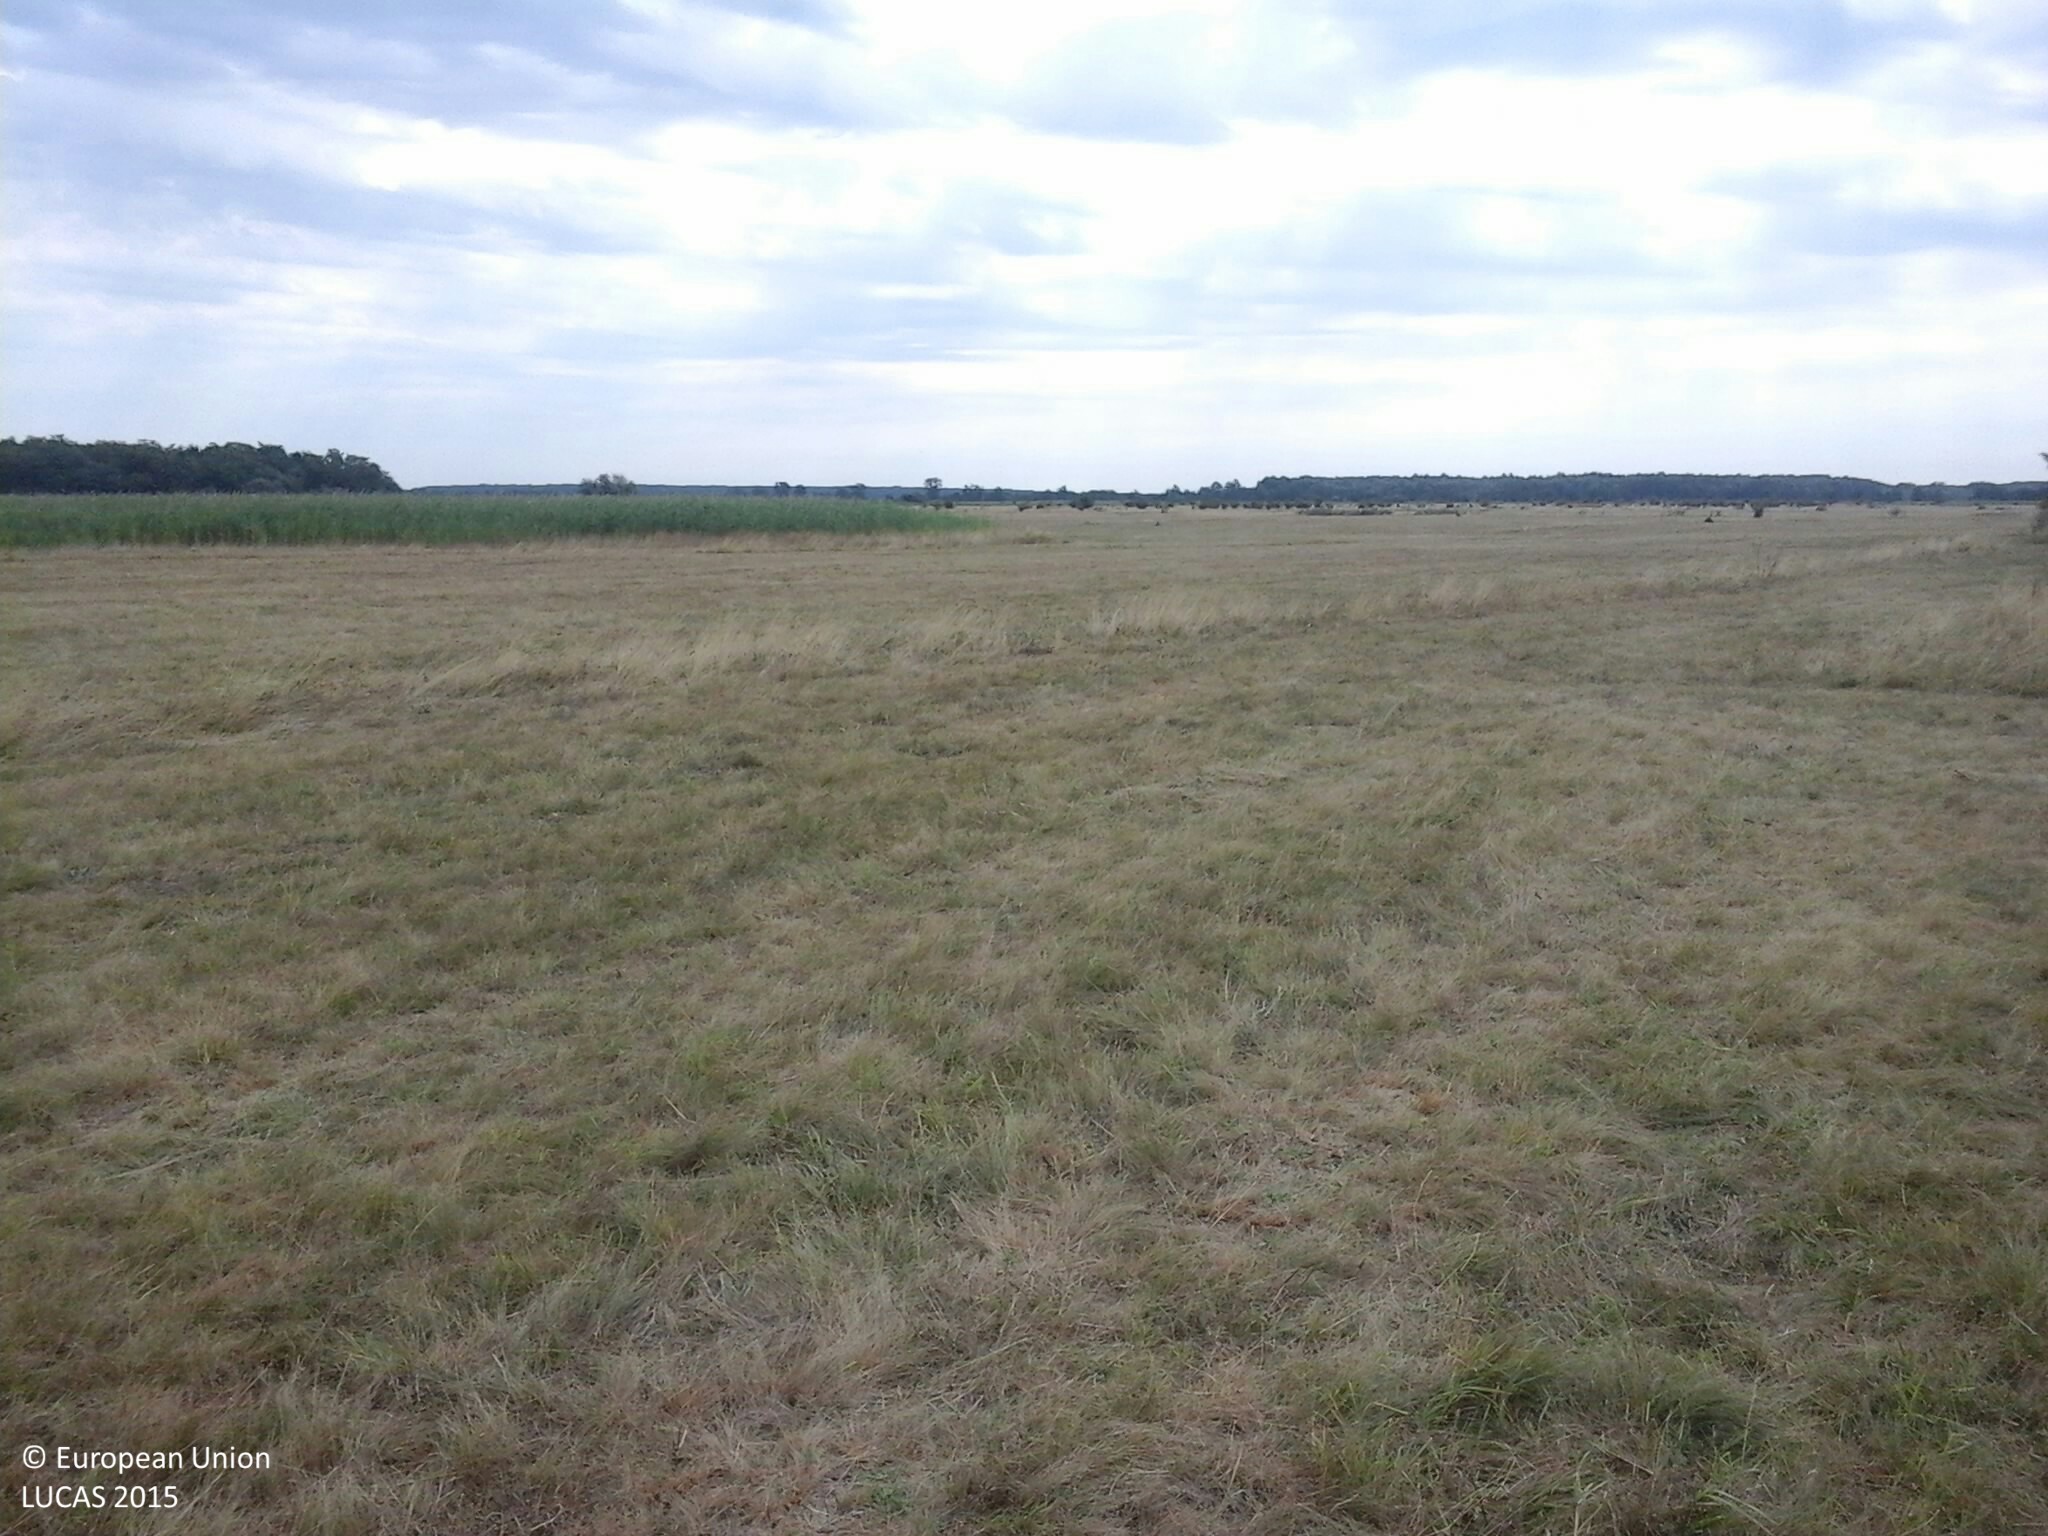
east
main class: Grassland
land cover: Grassland without tree/shrub cover
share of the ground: > 75 %
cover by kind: herbaceous plants 100 %
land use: Agriculture (excluding fallow land and kitchen gardens)
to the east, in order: Grassland without tree/shrub cover; Inland marshes; Grassland without tree/shrub cover
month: July
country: HU
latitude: 46.5276
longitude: 20.0739
